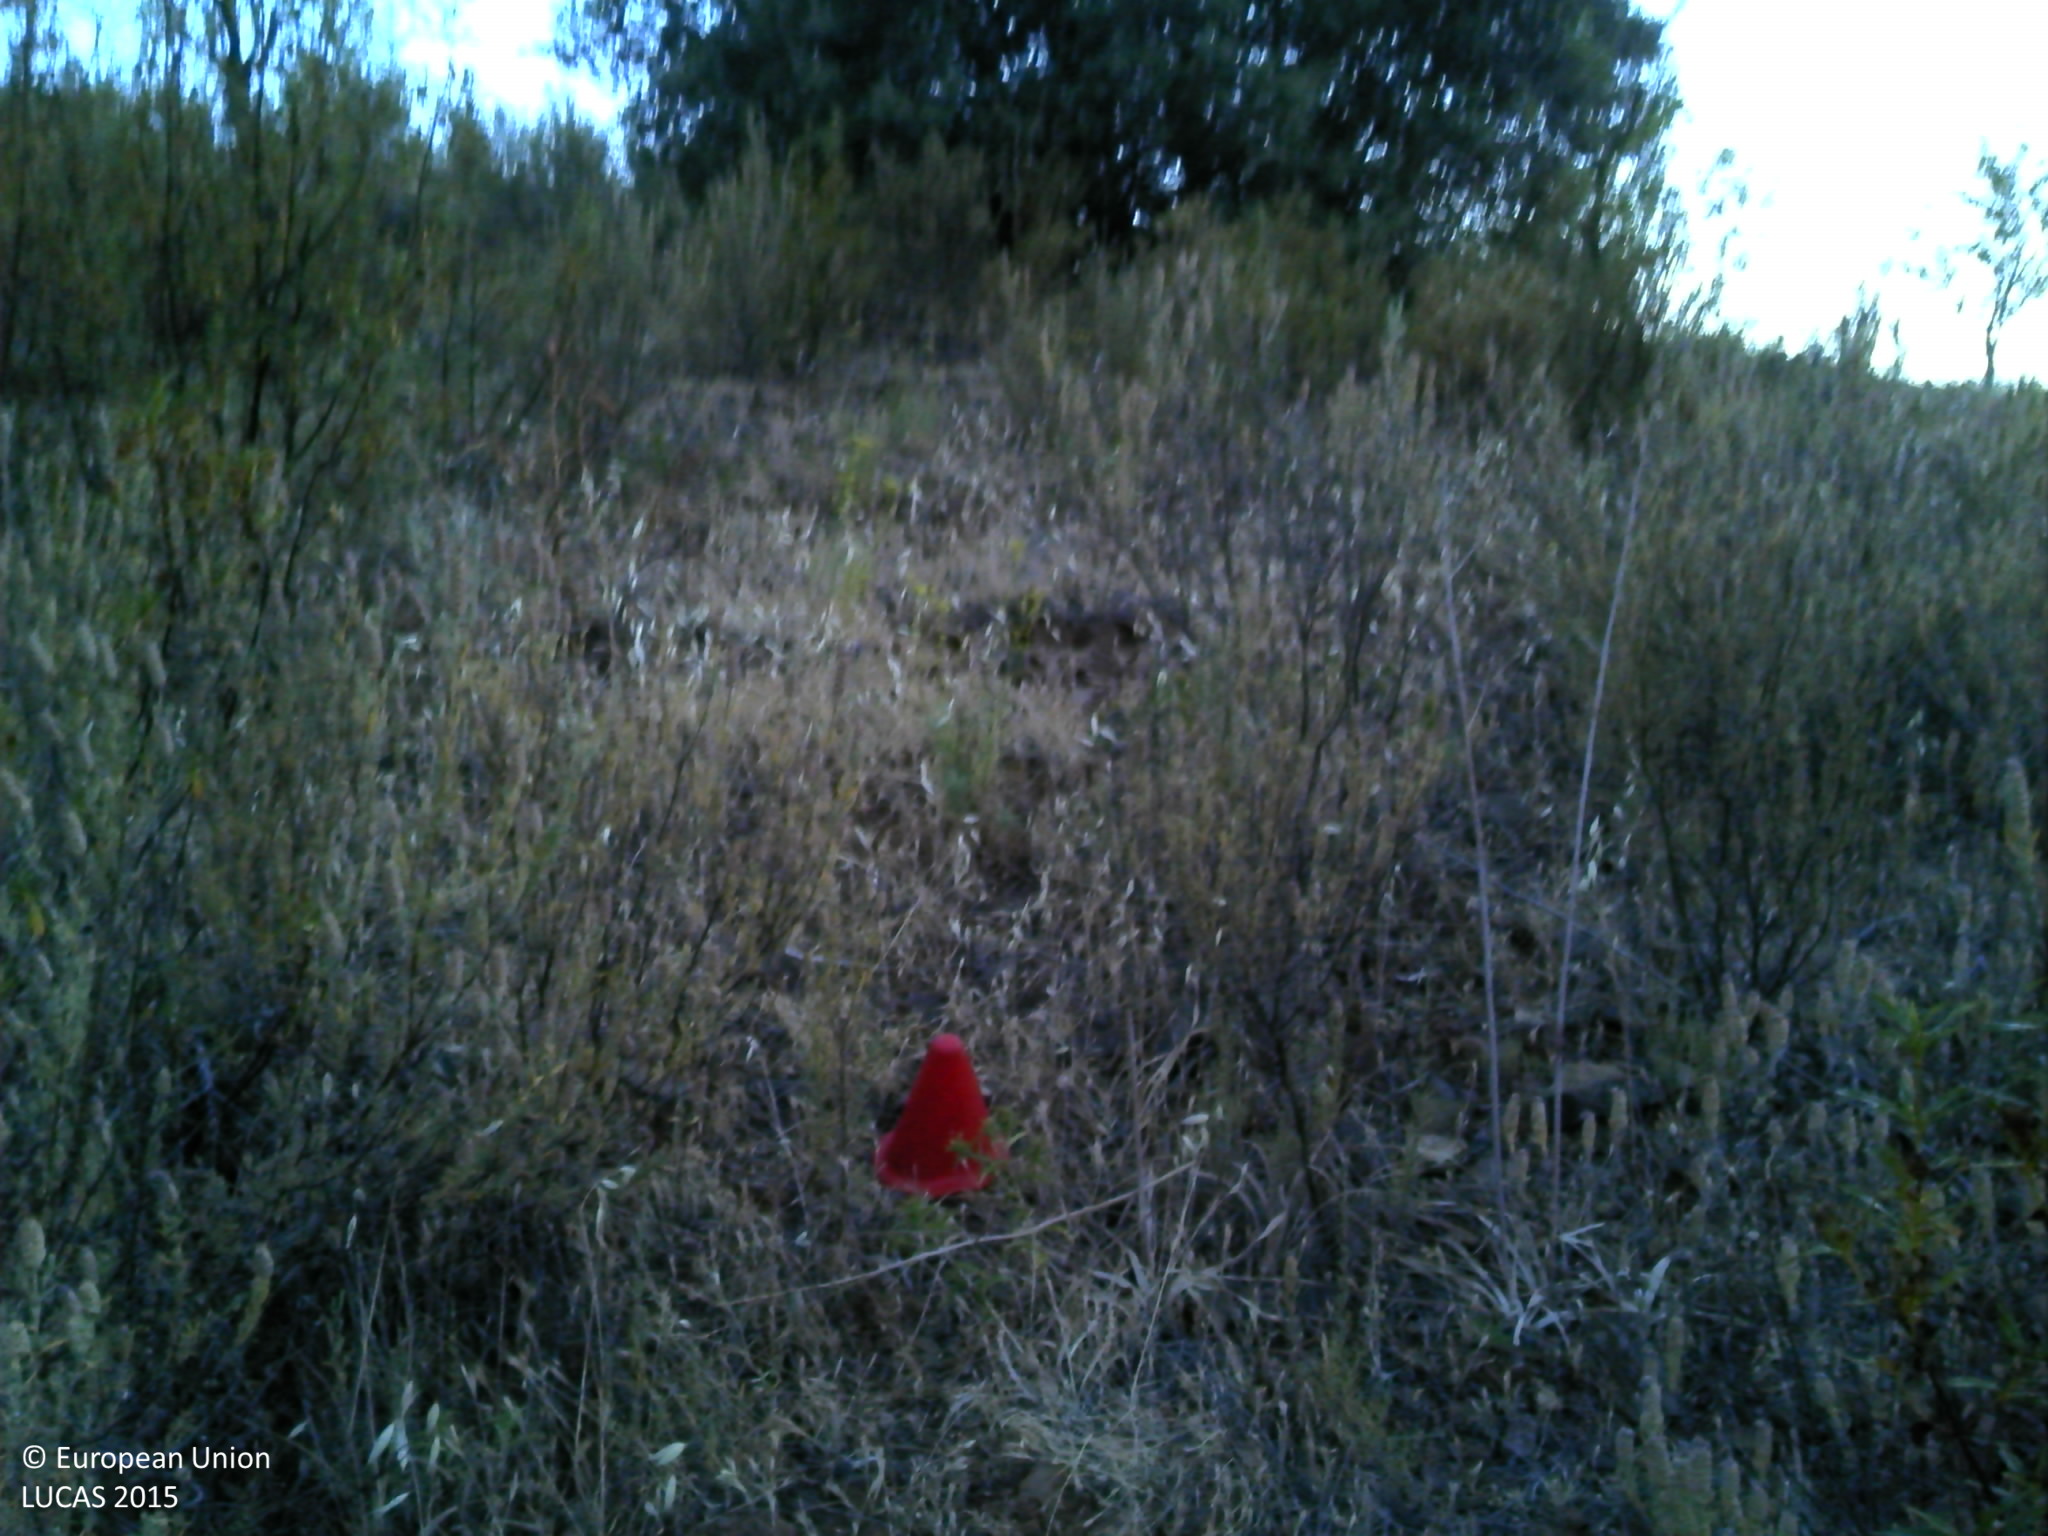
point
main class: Cropland
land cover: Nuts trees
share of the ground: 10 - 25 %
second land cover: Shrubland without tree cover
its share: 50 - 75 %
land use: Agriculture (excluding fallow land and kitchen gardens)
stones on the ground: < 10 %
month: May
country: PT
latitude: 37.2552
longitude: -7.5143
